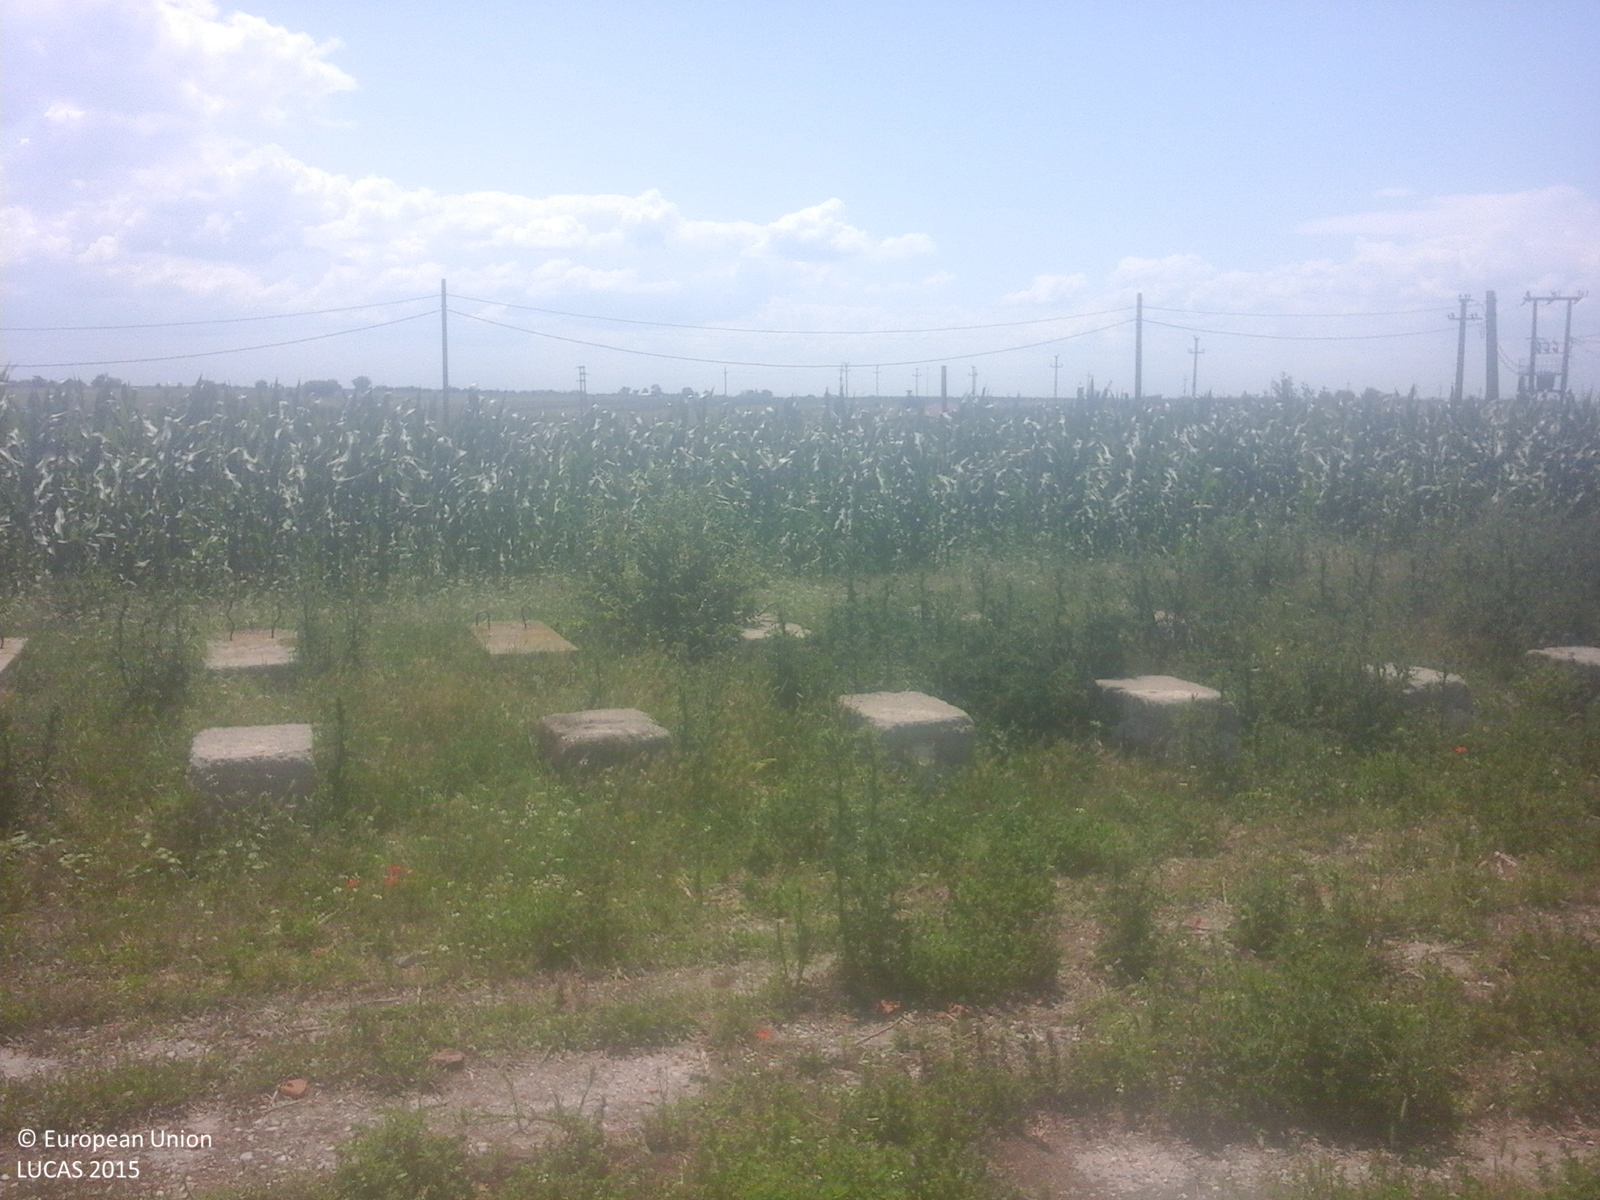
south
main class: Grassland
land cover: Spontaneously vegetated surfaces
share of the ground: > 75 %
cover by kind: herbaceous plants 90 %, consolidated bare surface 10 %
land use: Abandoned areas
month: July
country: RO
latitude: 44.1590
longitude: 25.5575
